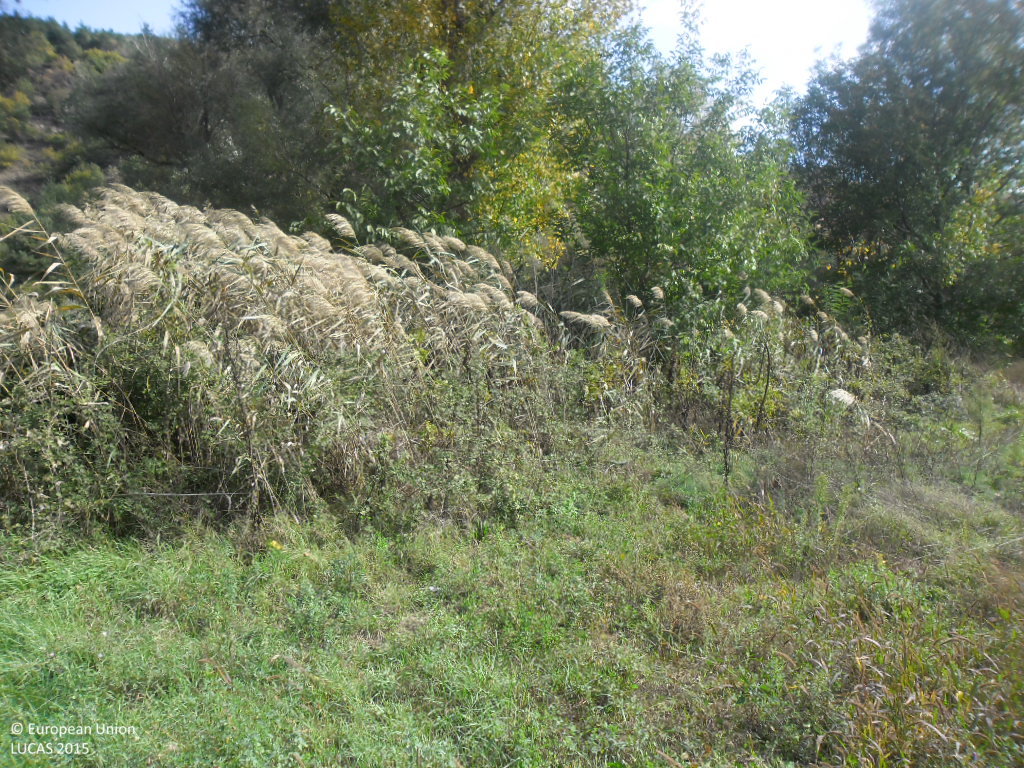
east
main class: Grassland
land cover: Spontaneously vegetated surfaces
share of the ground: > 75 %
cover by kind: herbaceous plants 100 %
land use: Agriculture (excluding fallow land and kitchen gardens)
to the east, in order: Spontaneously vegetated surfaces; Other bare soil; Broadleaved woodland; Inland salty running water; Grassland with sparse tree/shrub cover; Paved roads, cycling and walking lanes; Rocks and stones; Broadleaved woodland; Tracks; Grassland with sparse tree/shrub cover; Electric lines; Grassland with sparse tree/shrub cover
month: October
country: BG
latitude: 41.9261
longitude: 23.1073
